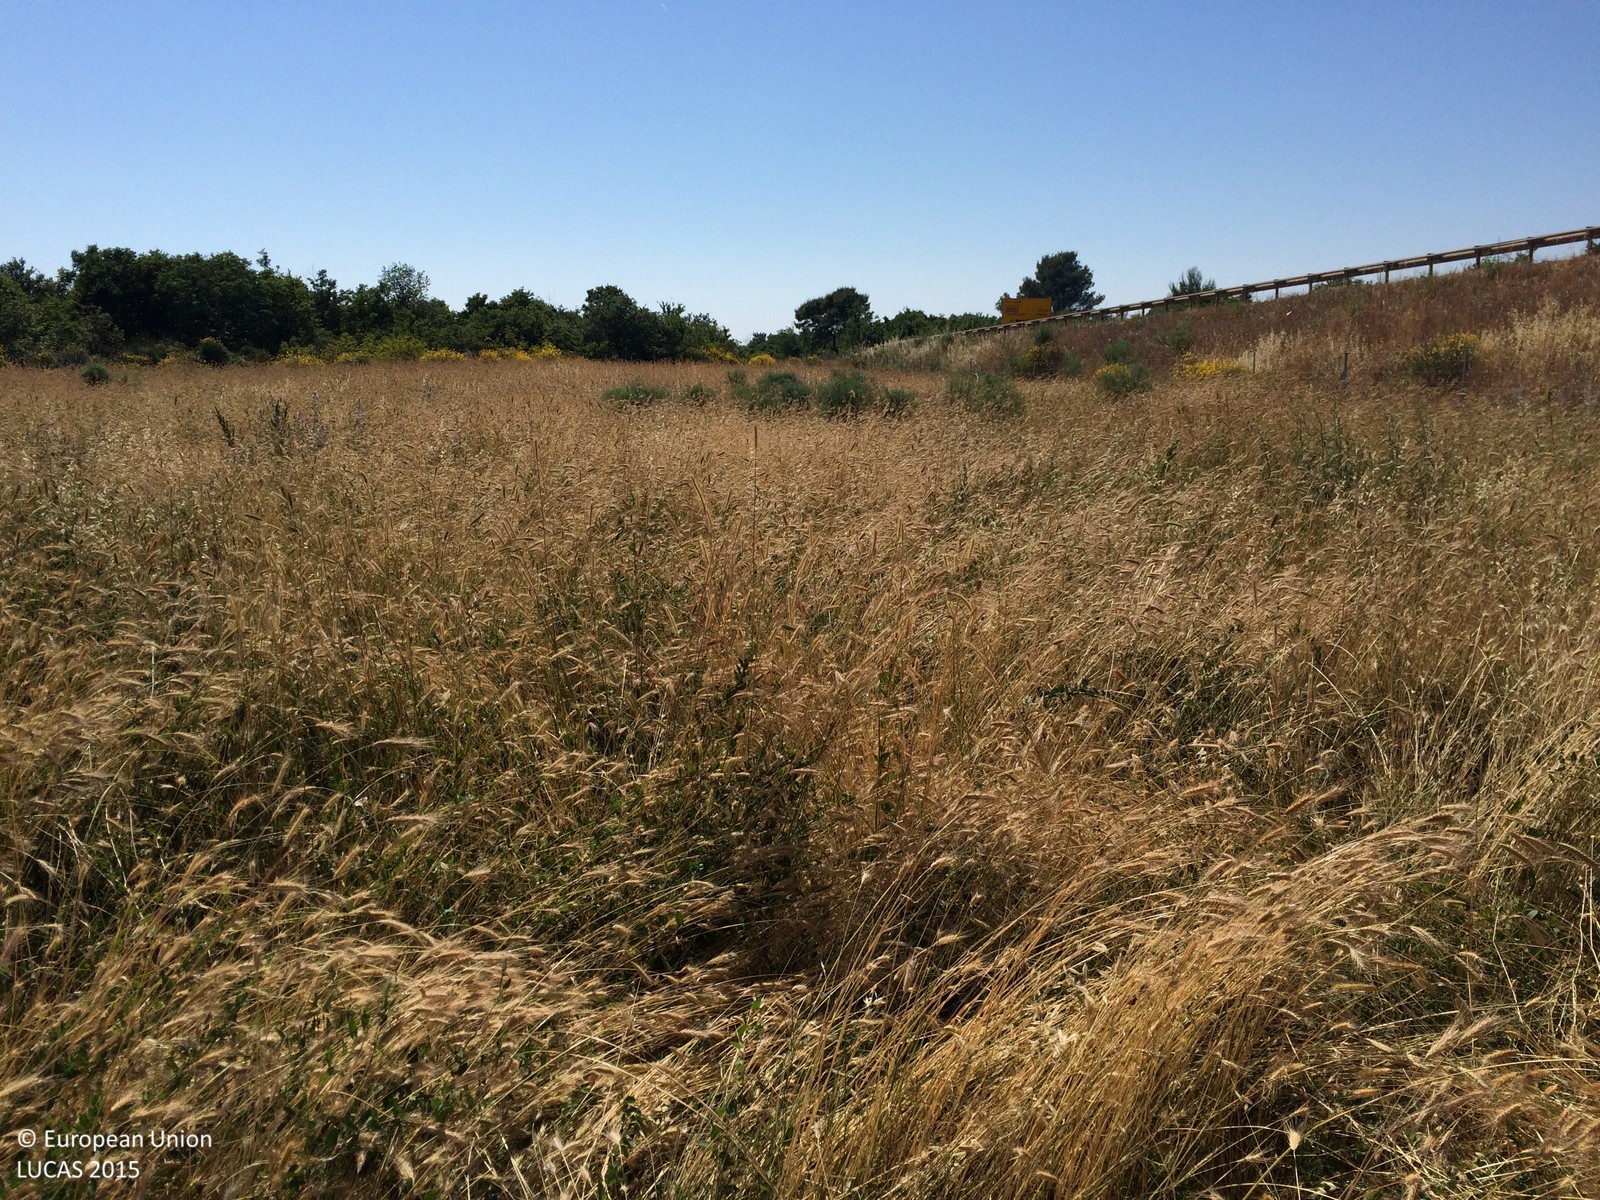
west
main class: Grassland
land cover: Grassland without tree/shrub cover
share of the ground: > 75 %
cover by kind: herbaceous plants 95 %, shrubs 5 %
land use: Semi-natural and natural areas not in use
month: June
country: HR
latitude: 44.9467
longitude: 13.8598
